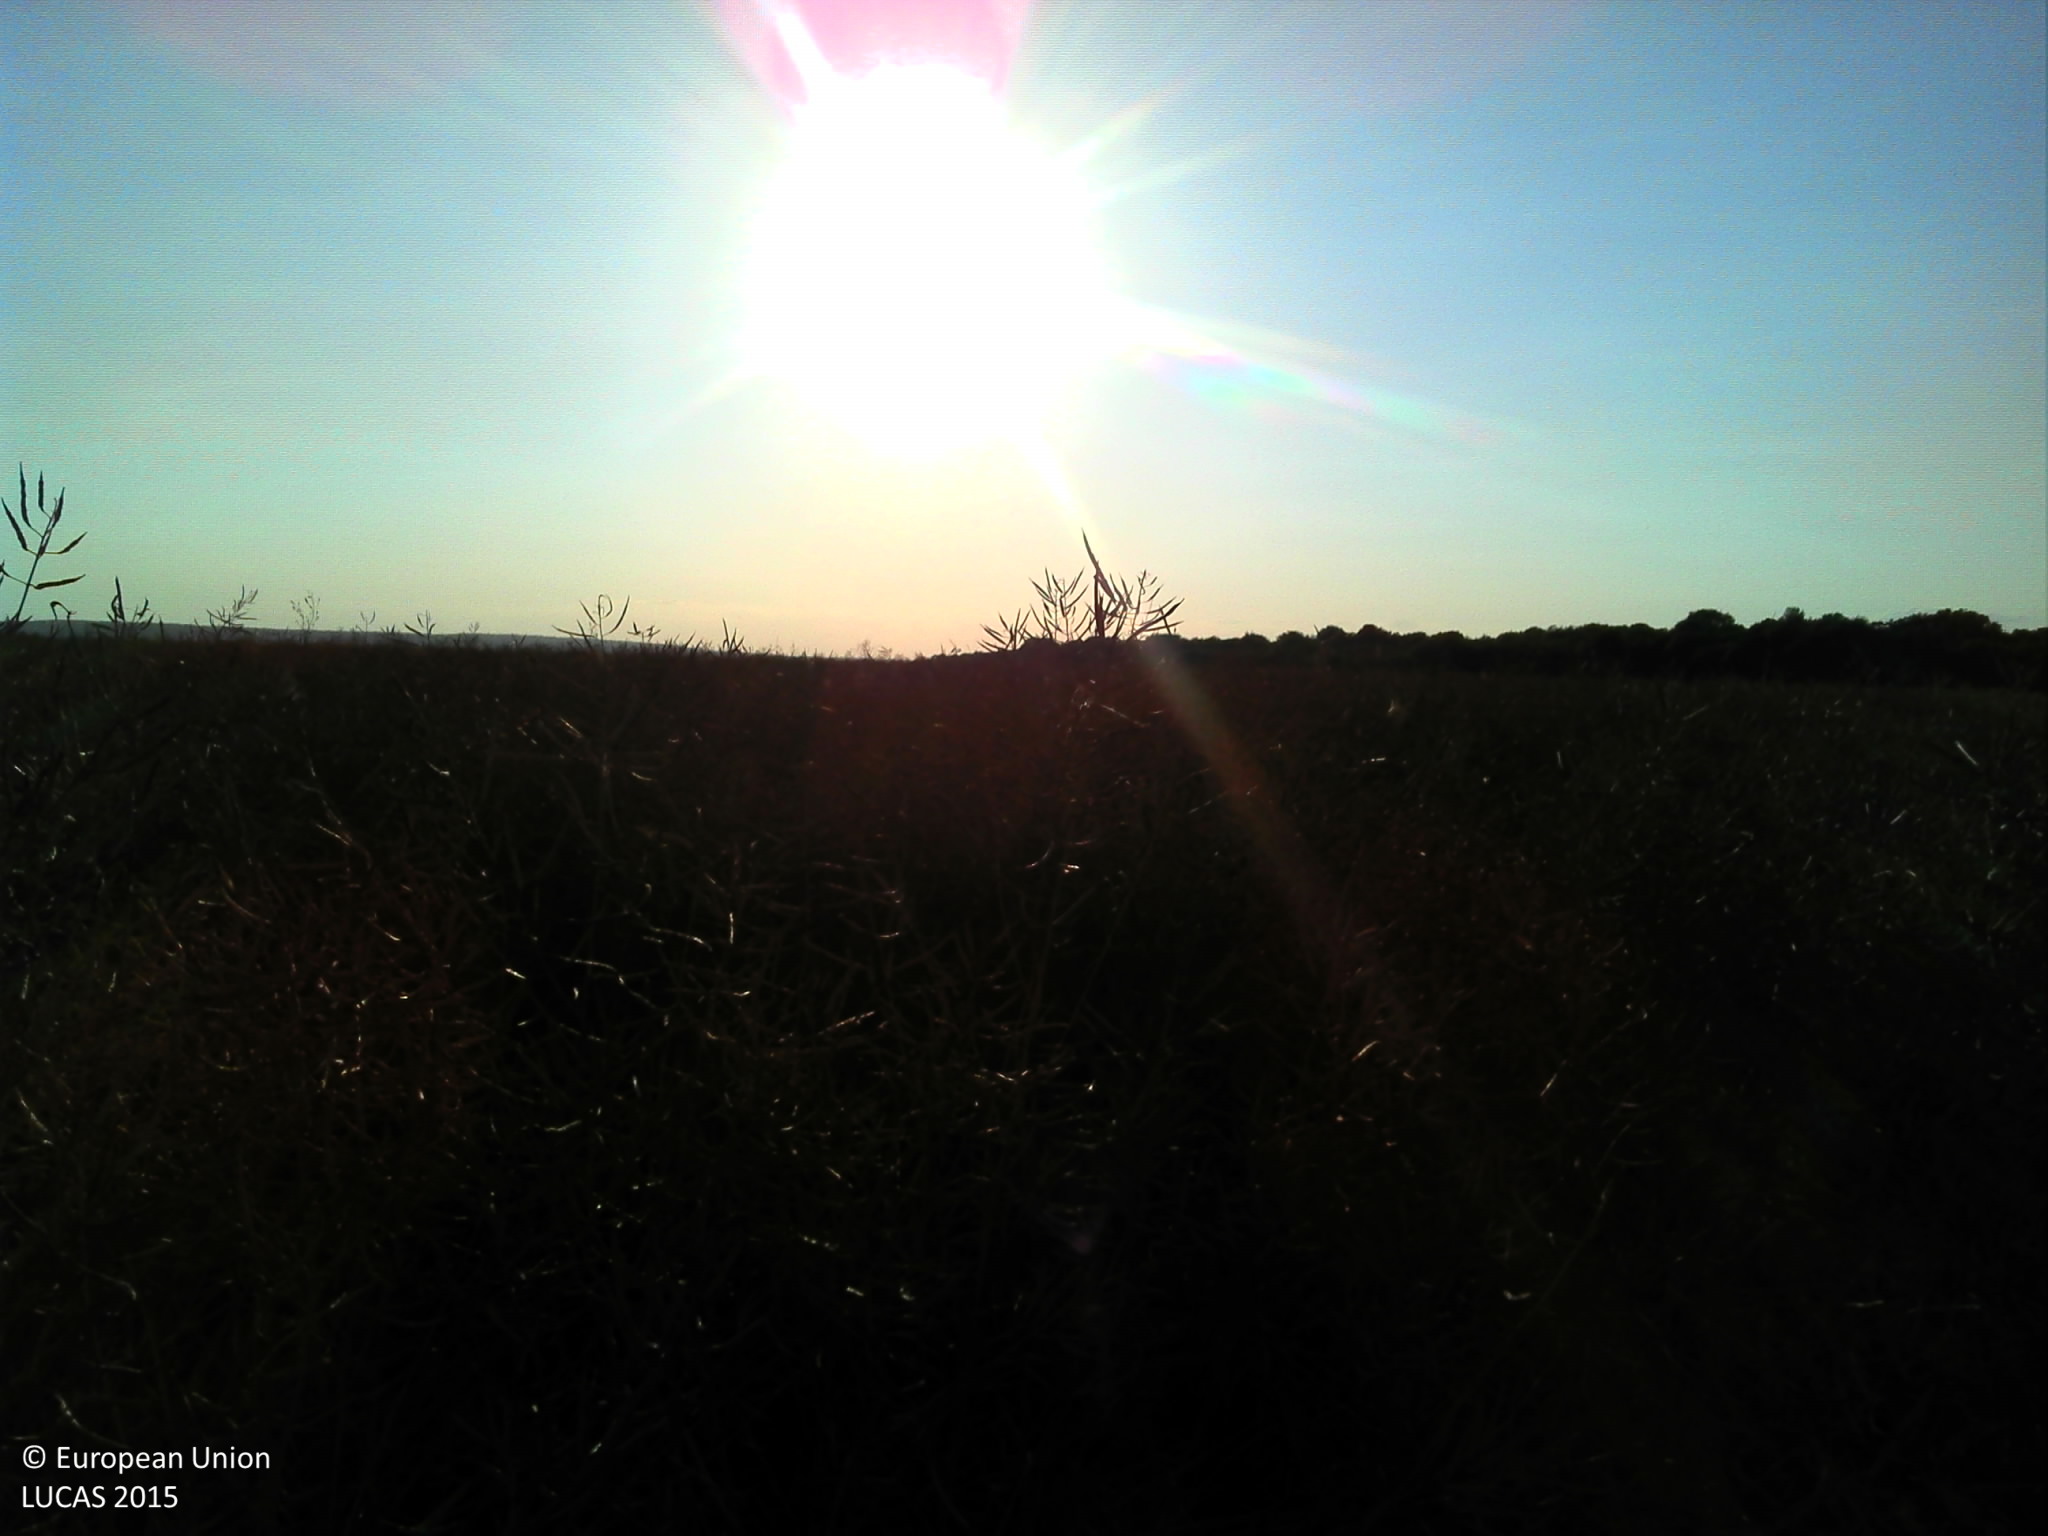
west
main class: Cropland
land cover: Rape and turnip rape
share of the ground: > 75 %
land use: Agriculture (excluding fallow land and kitchen gardens)
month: July
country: FR
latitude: 48.0366
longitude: 4.9695
